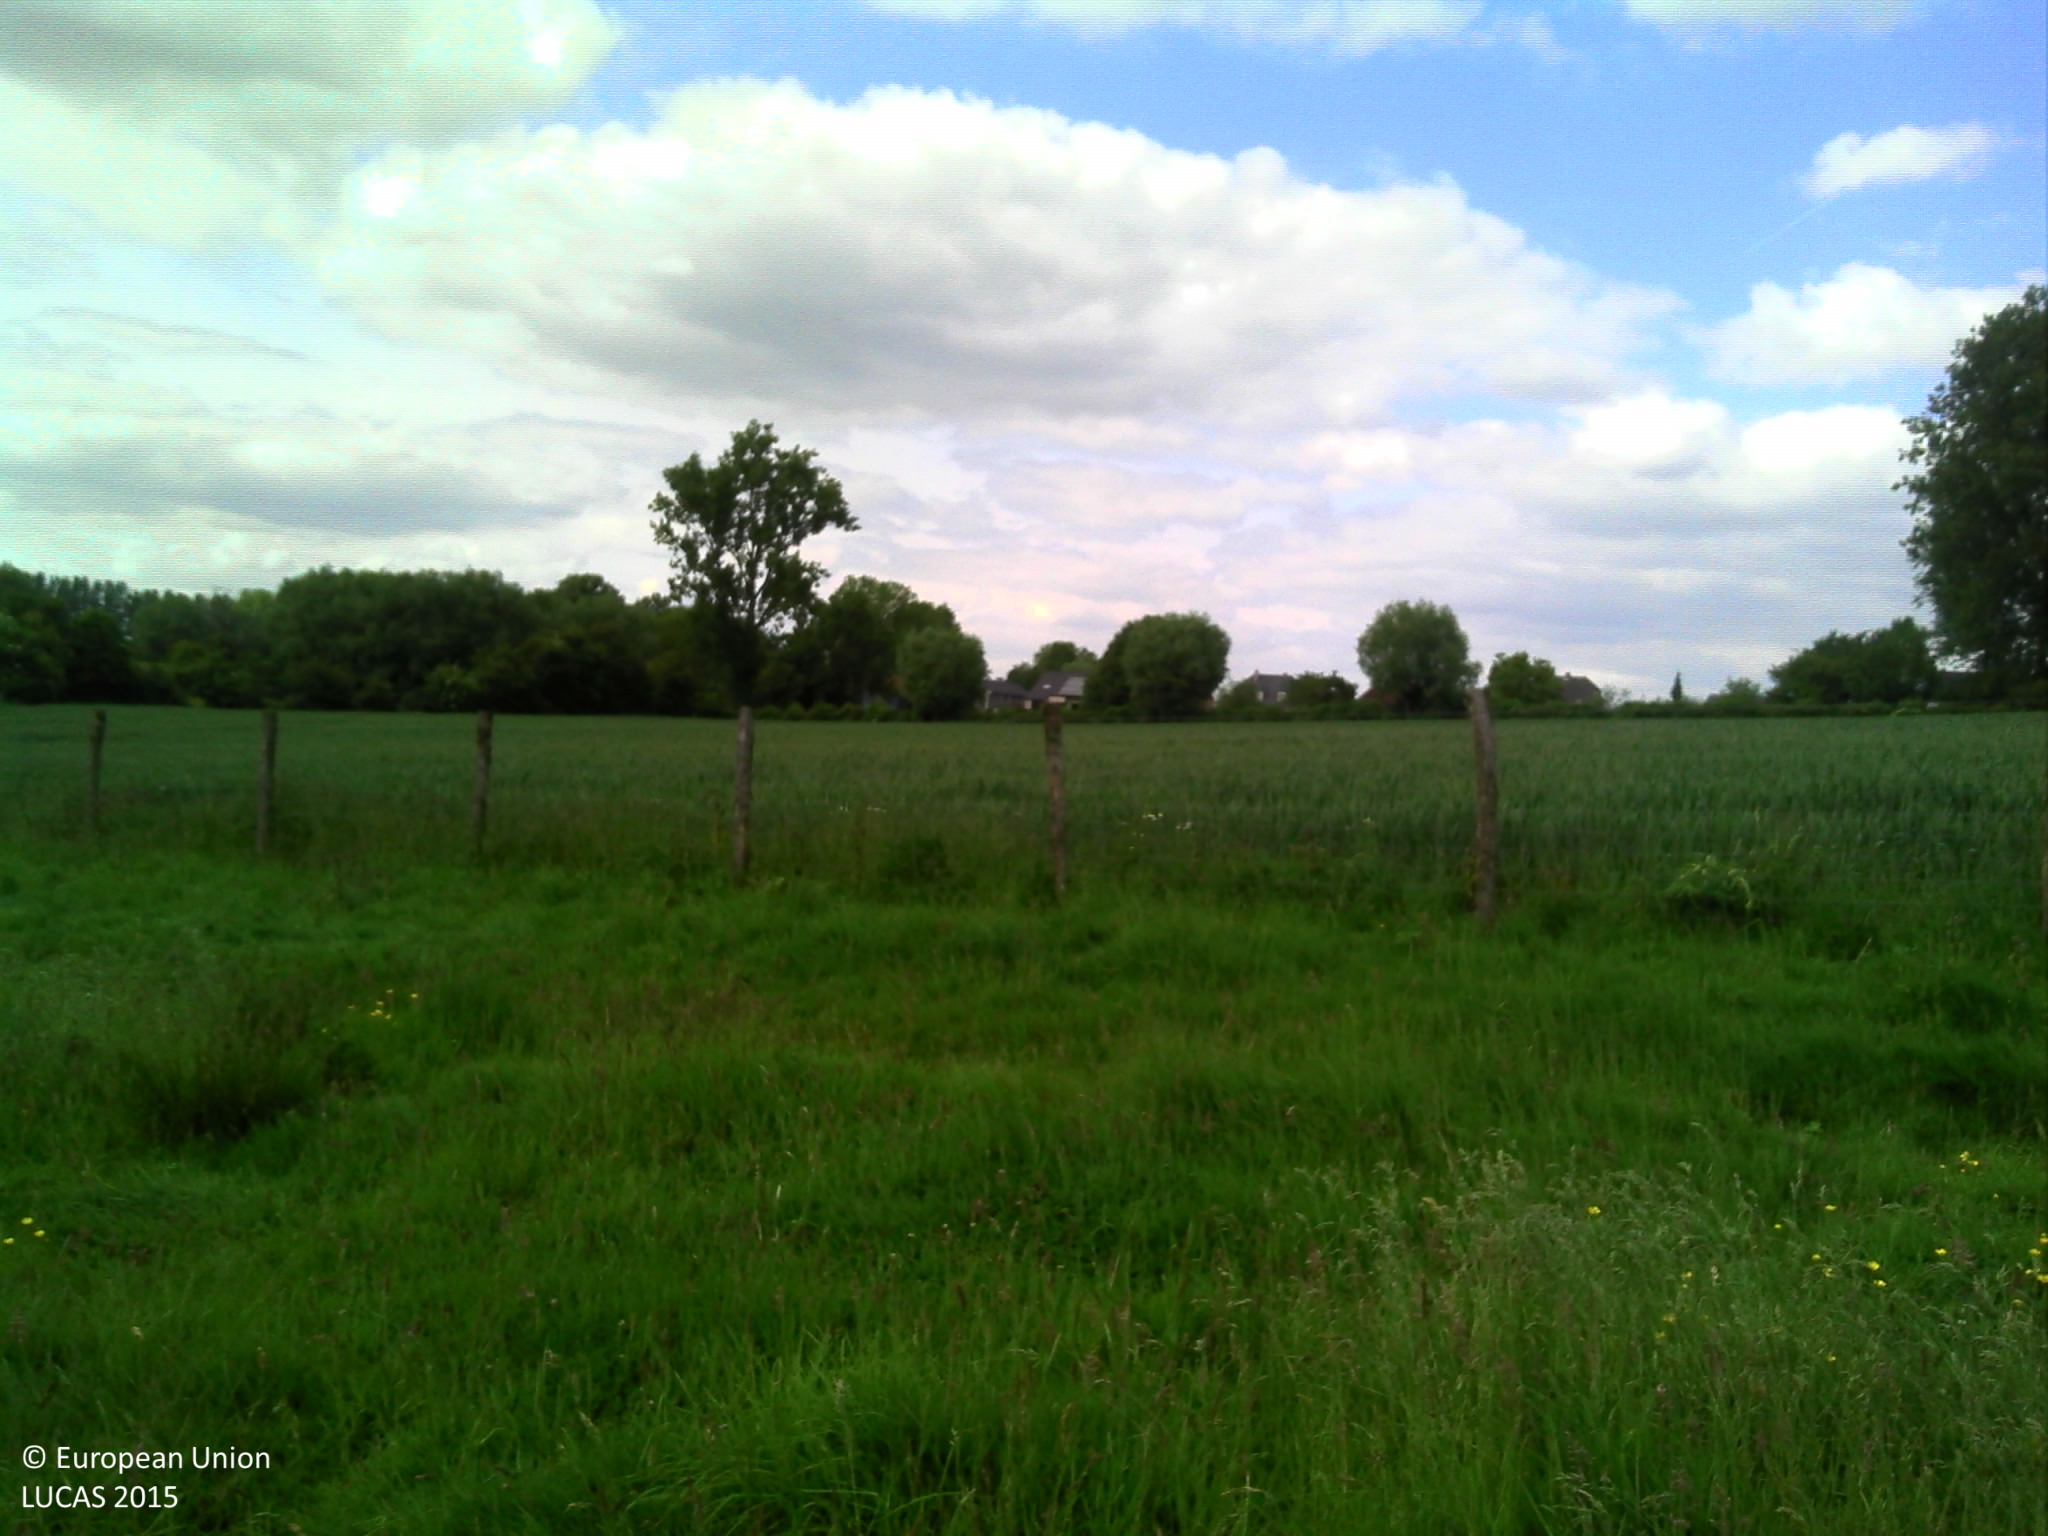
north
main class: Grassland
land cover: Grassland without tree/shrub cover
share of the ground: > 75 %
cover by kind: herbaceous plants 100 %
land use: Agriculture (excluding fallow land and kitchen gardens)
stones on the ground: < 10 %
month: June
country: BE
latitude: 50.7833
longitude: 3.9945
